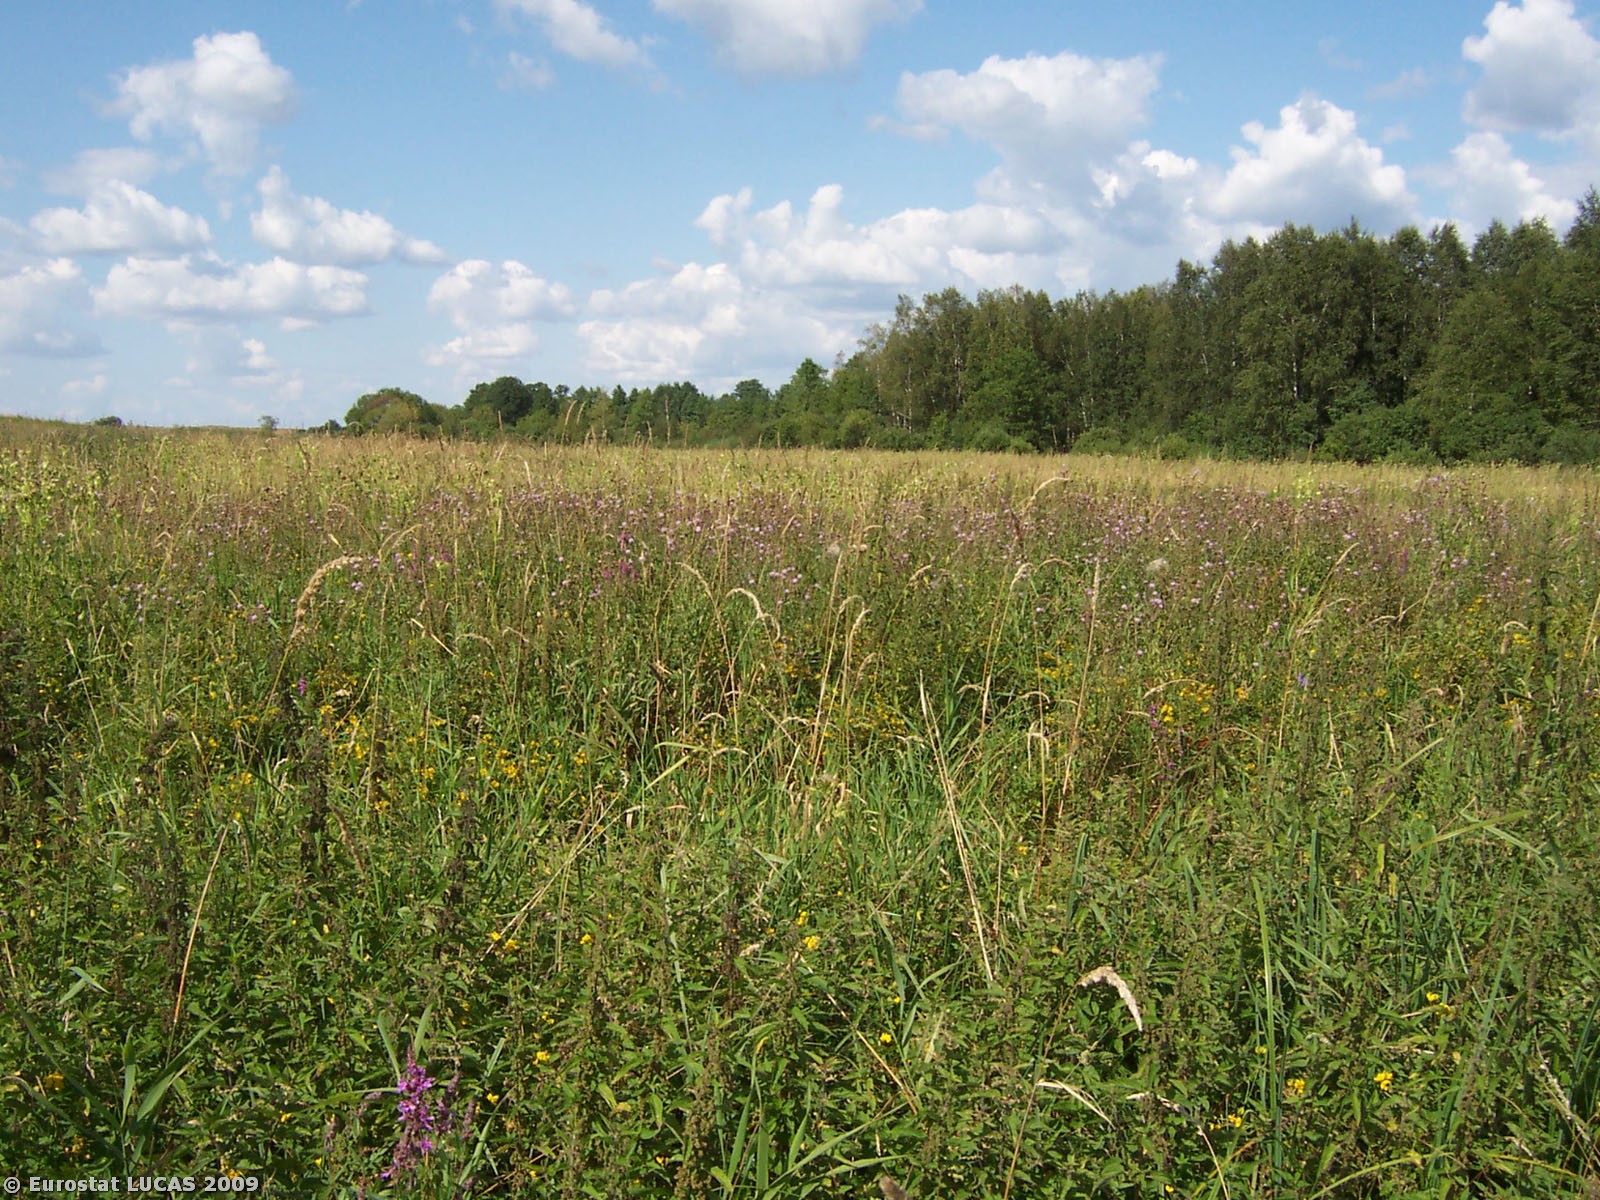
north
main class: Grassland
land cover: Spontaneously vegetated surfaces
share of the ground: > 75 %
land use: Nature reserves
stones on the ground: < 10 %
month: August
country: PL
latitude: 53.7611
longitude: 21.1025
